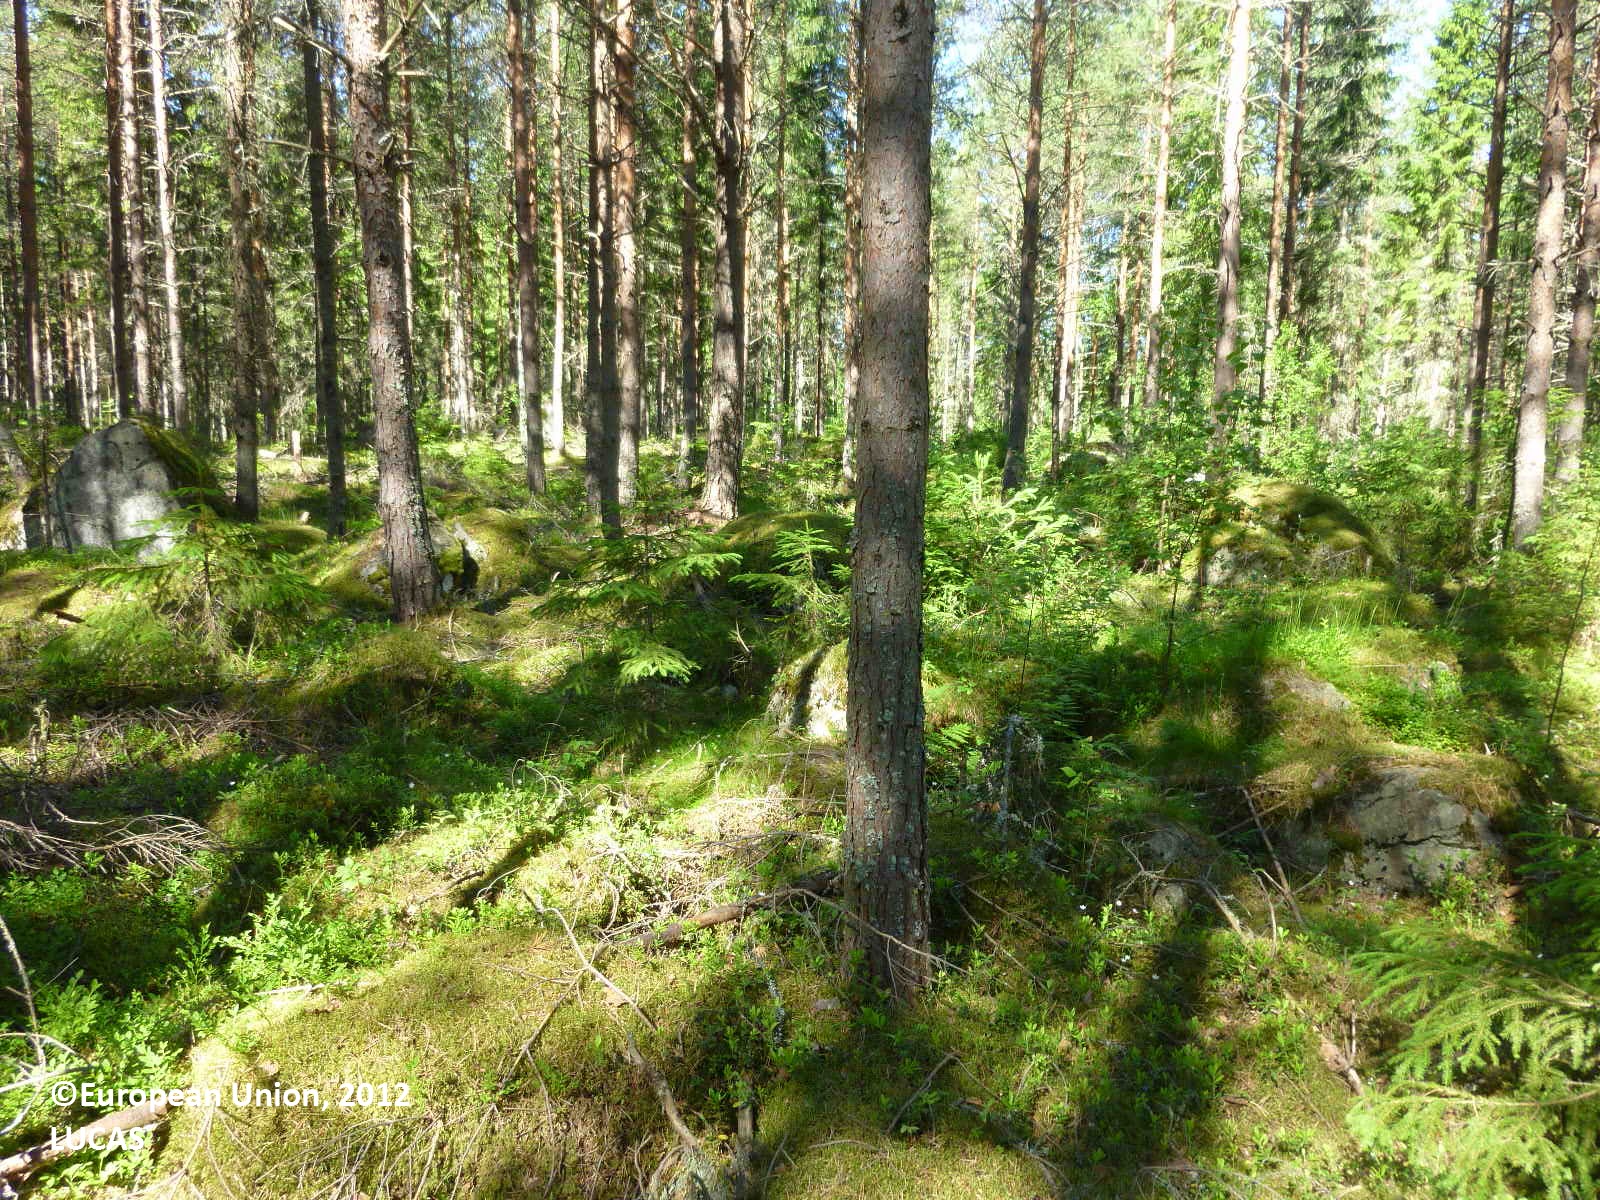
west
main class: Woodland
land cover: Pine dominated coniferous woodland
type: boreal forest
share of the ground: 50 - 75 %
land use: Forestry
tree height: > 5 m
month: June
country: FI
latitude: 61.6250
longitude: 22.1485
